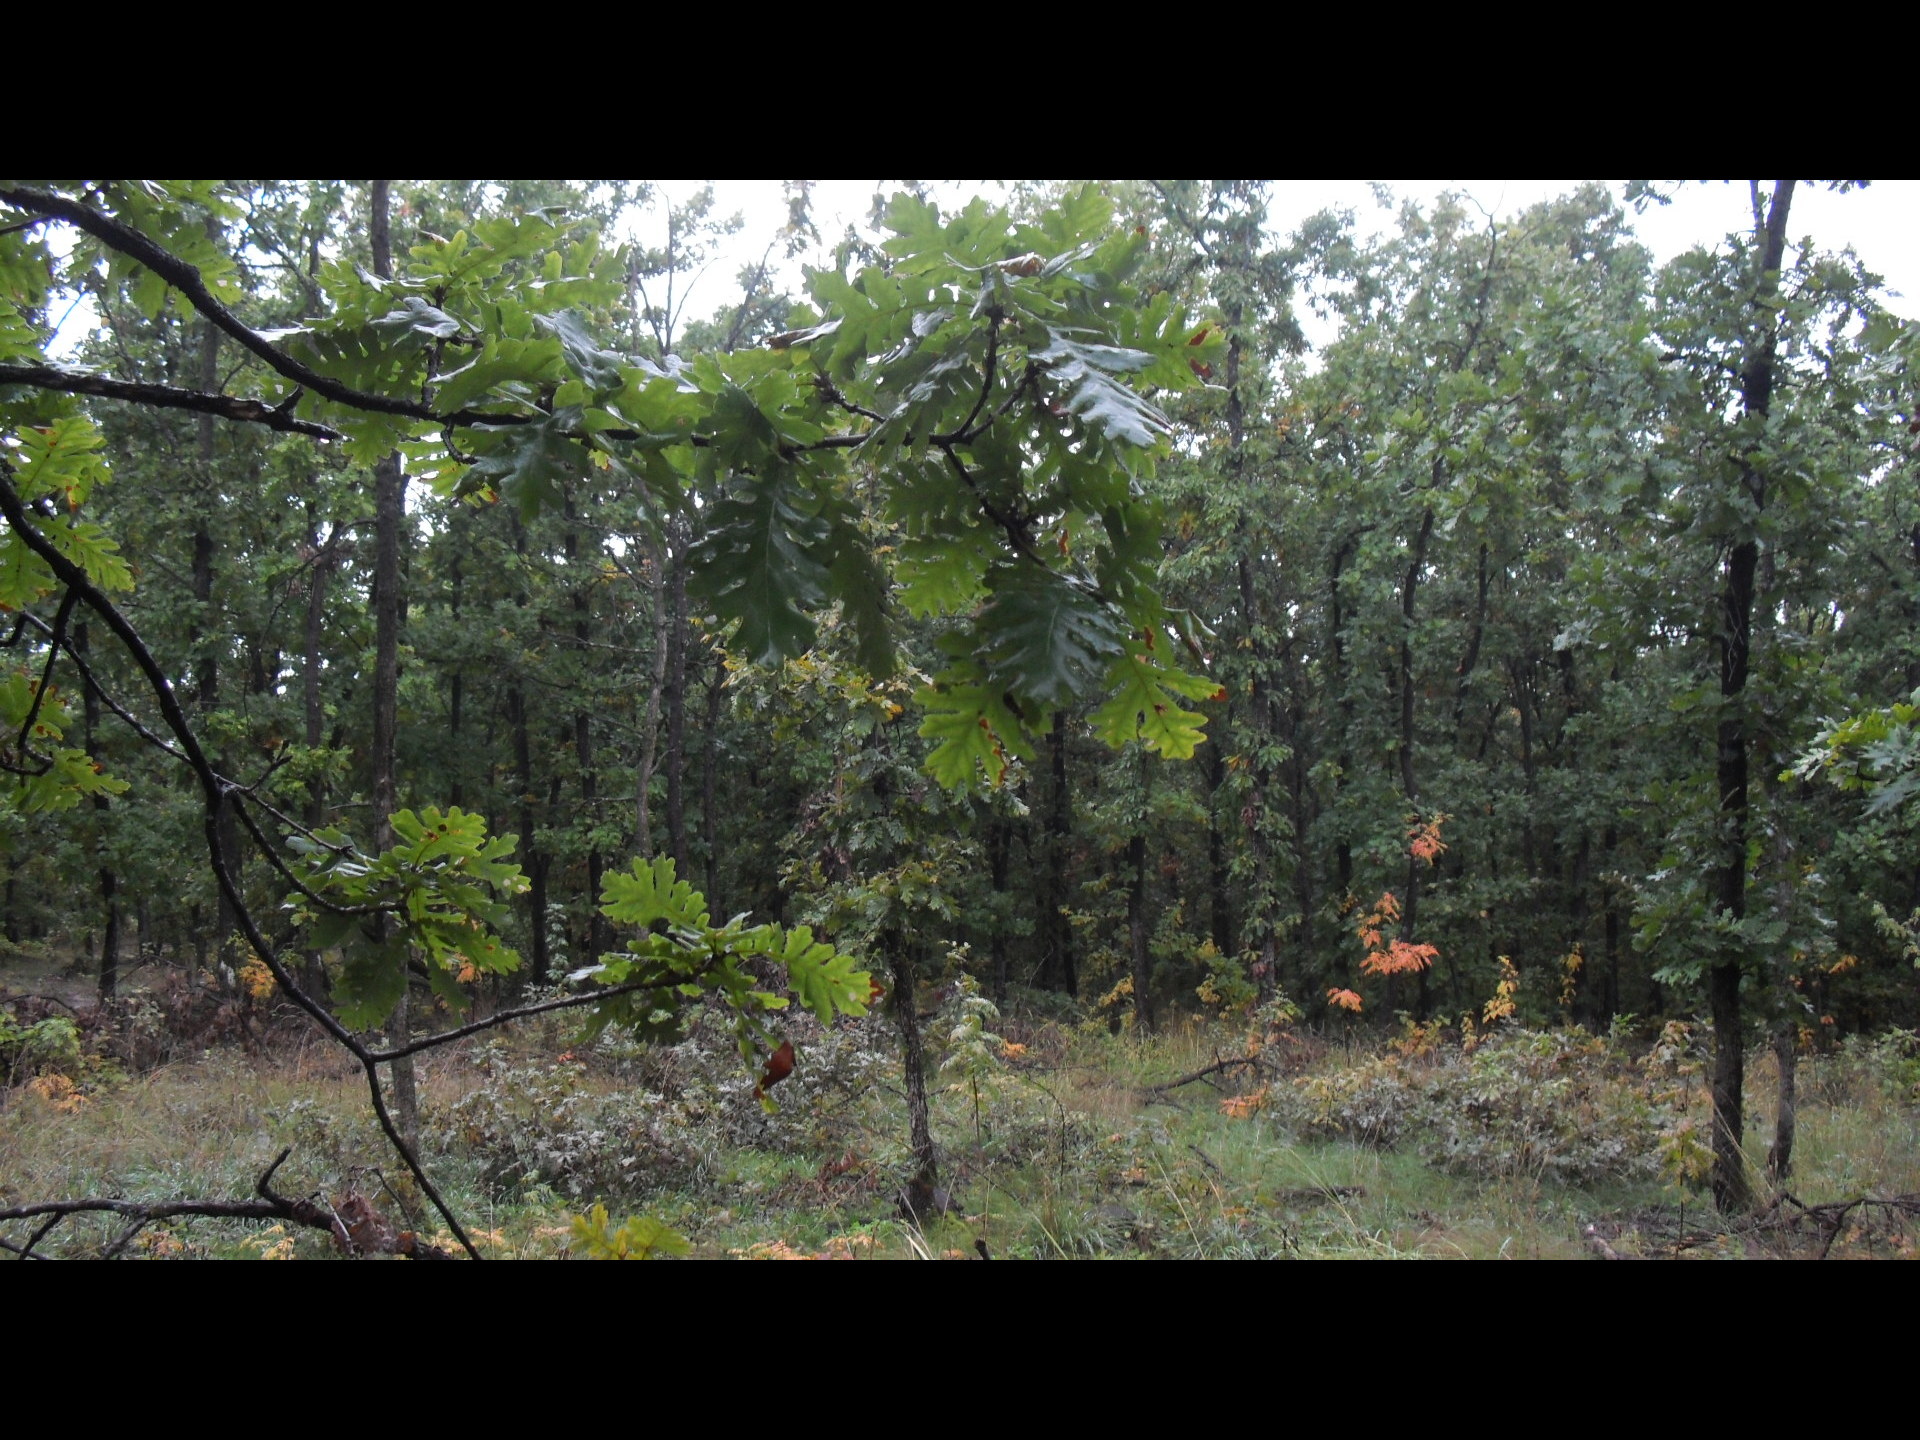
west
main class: Woodland
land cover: Broadleaved woodland
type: mesophytic deciduous forest
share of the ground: > 75 %
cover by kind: broadleaved forest trees 80 %, herbaceous plants 20 %
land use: Forestry
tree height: > 5 m
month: October
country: BG
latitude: 43.7062
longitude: 22.6046
